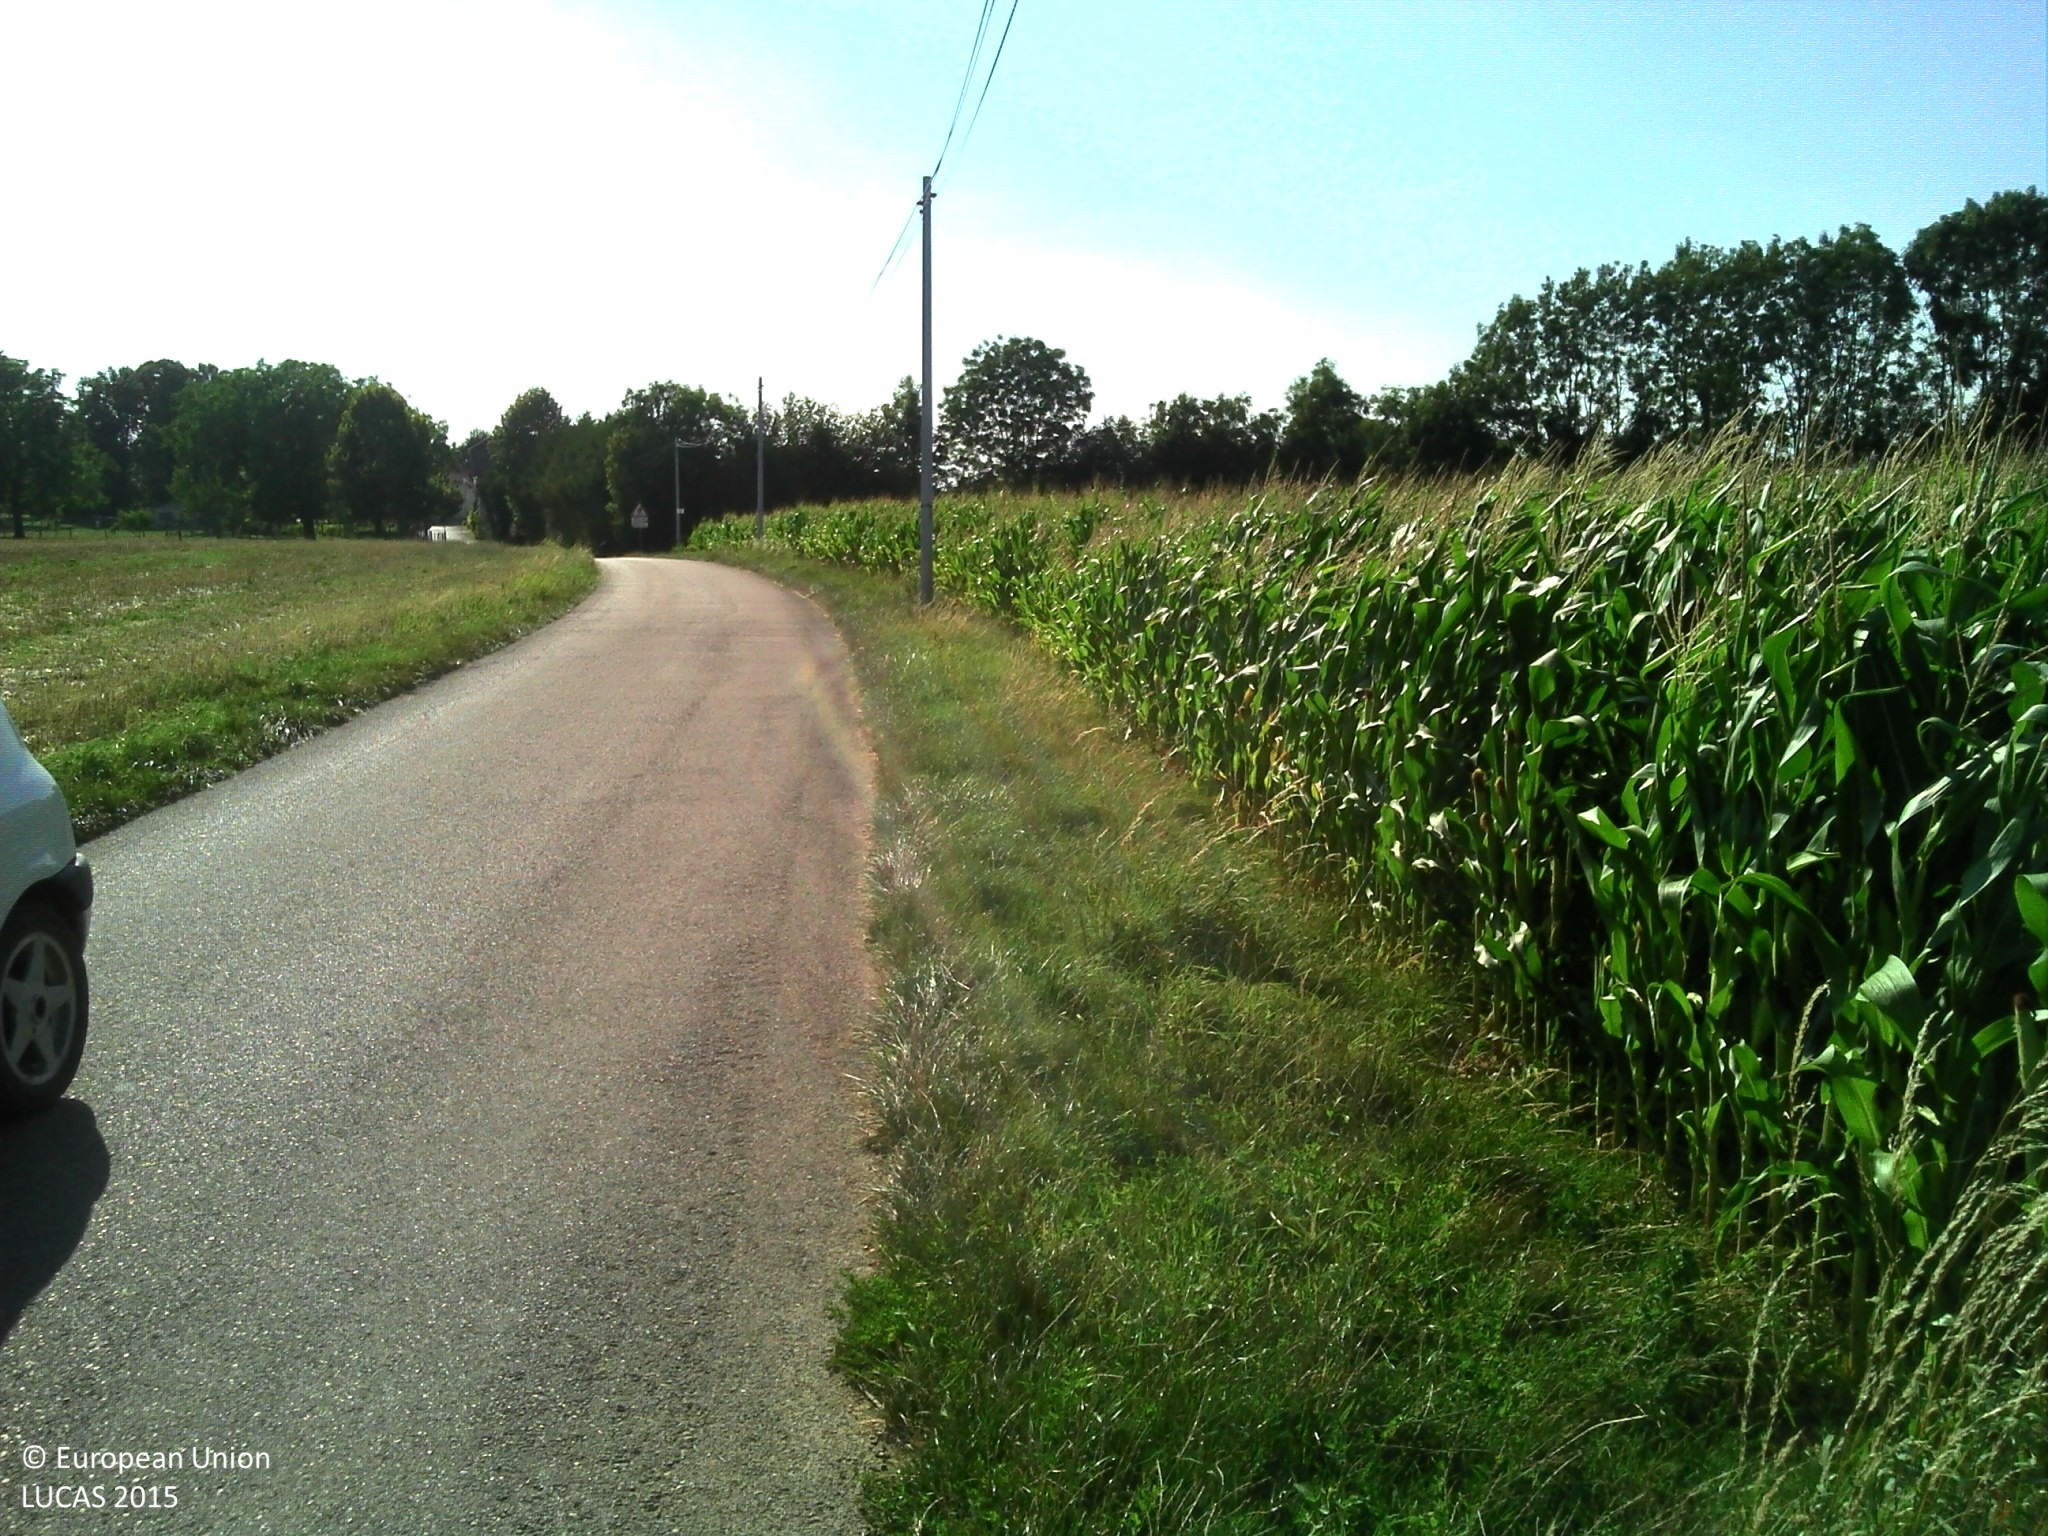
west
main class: Cropland
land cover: Maize
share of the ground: > 75 %
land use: Agriculture (excluding fallow land and kitchen gardens)
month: August
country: FR
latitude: 45.5151
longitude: 5.4602
